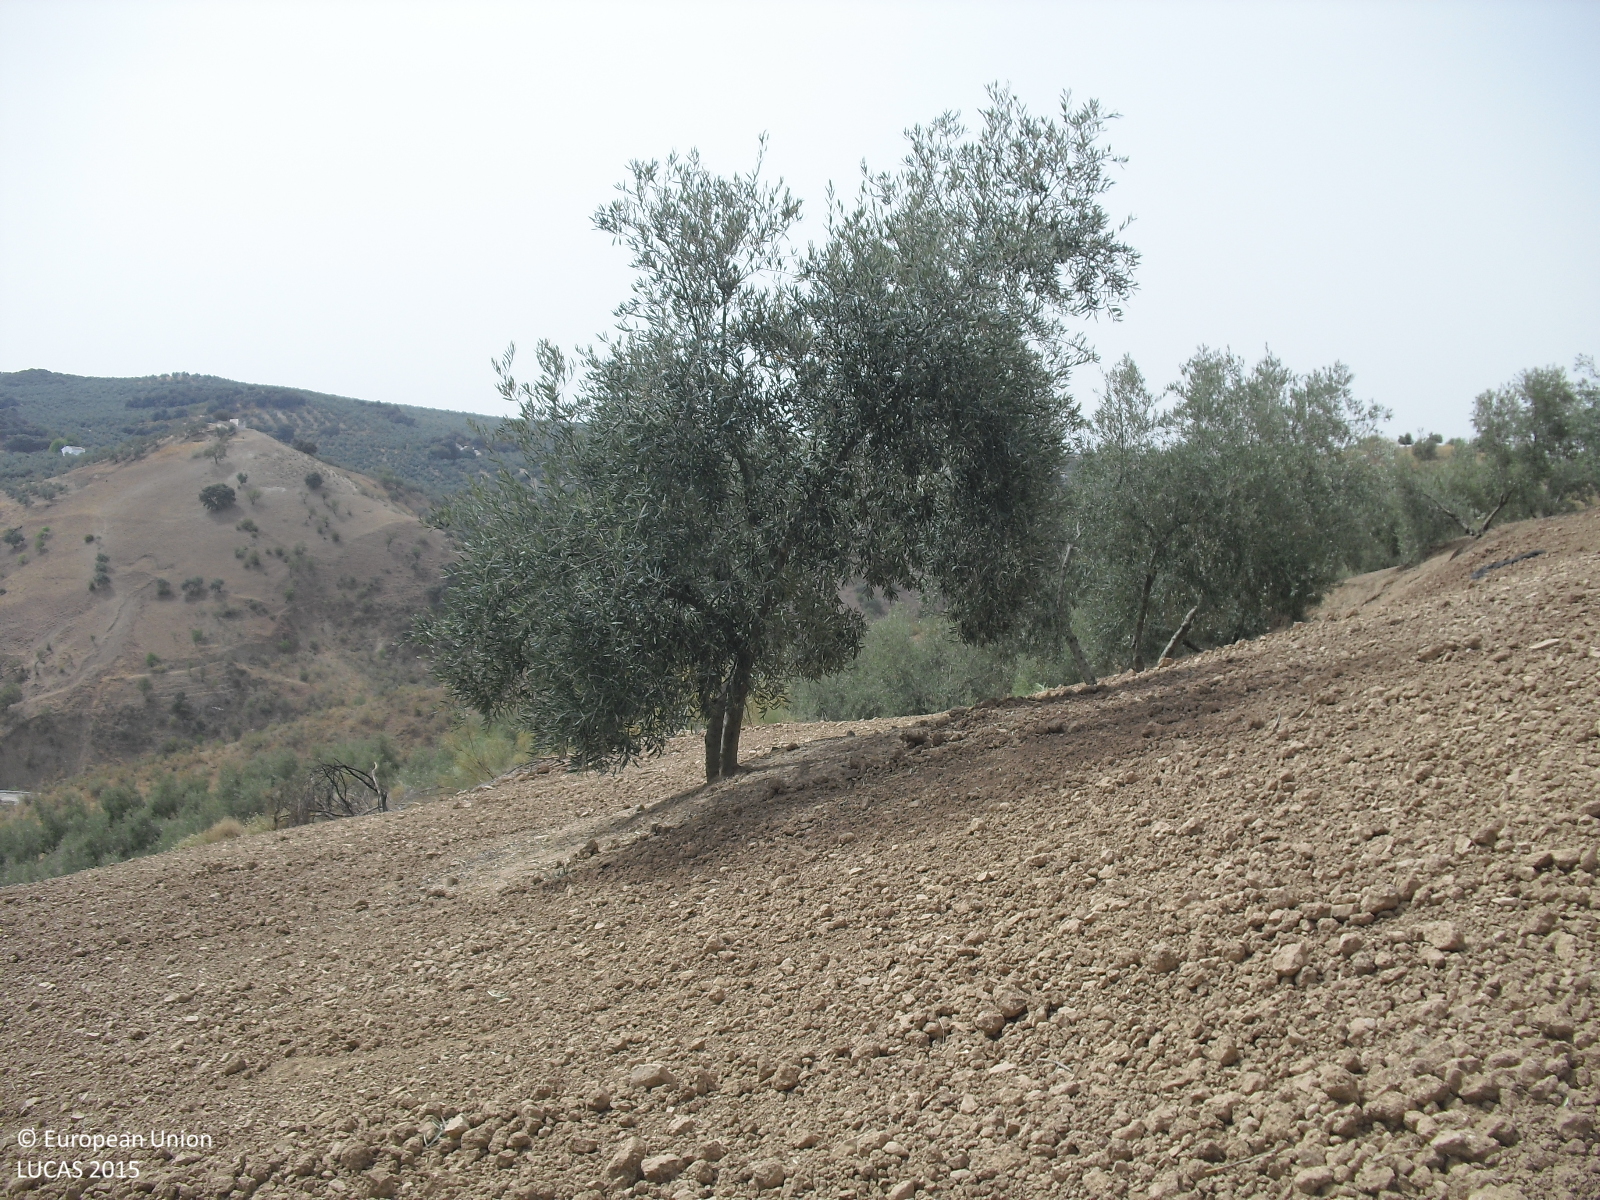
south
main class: Cropland
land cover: Olive groves
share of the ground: 25 - 50 %
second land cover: Other bare soil
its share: > 75 %
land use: Agriculture (excluding fallow land and kitchen gardens)
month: August
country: ES
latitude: 37.2094
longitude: -4.3188
